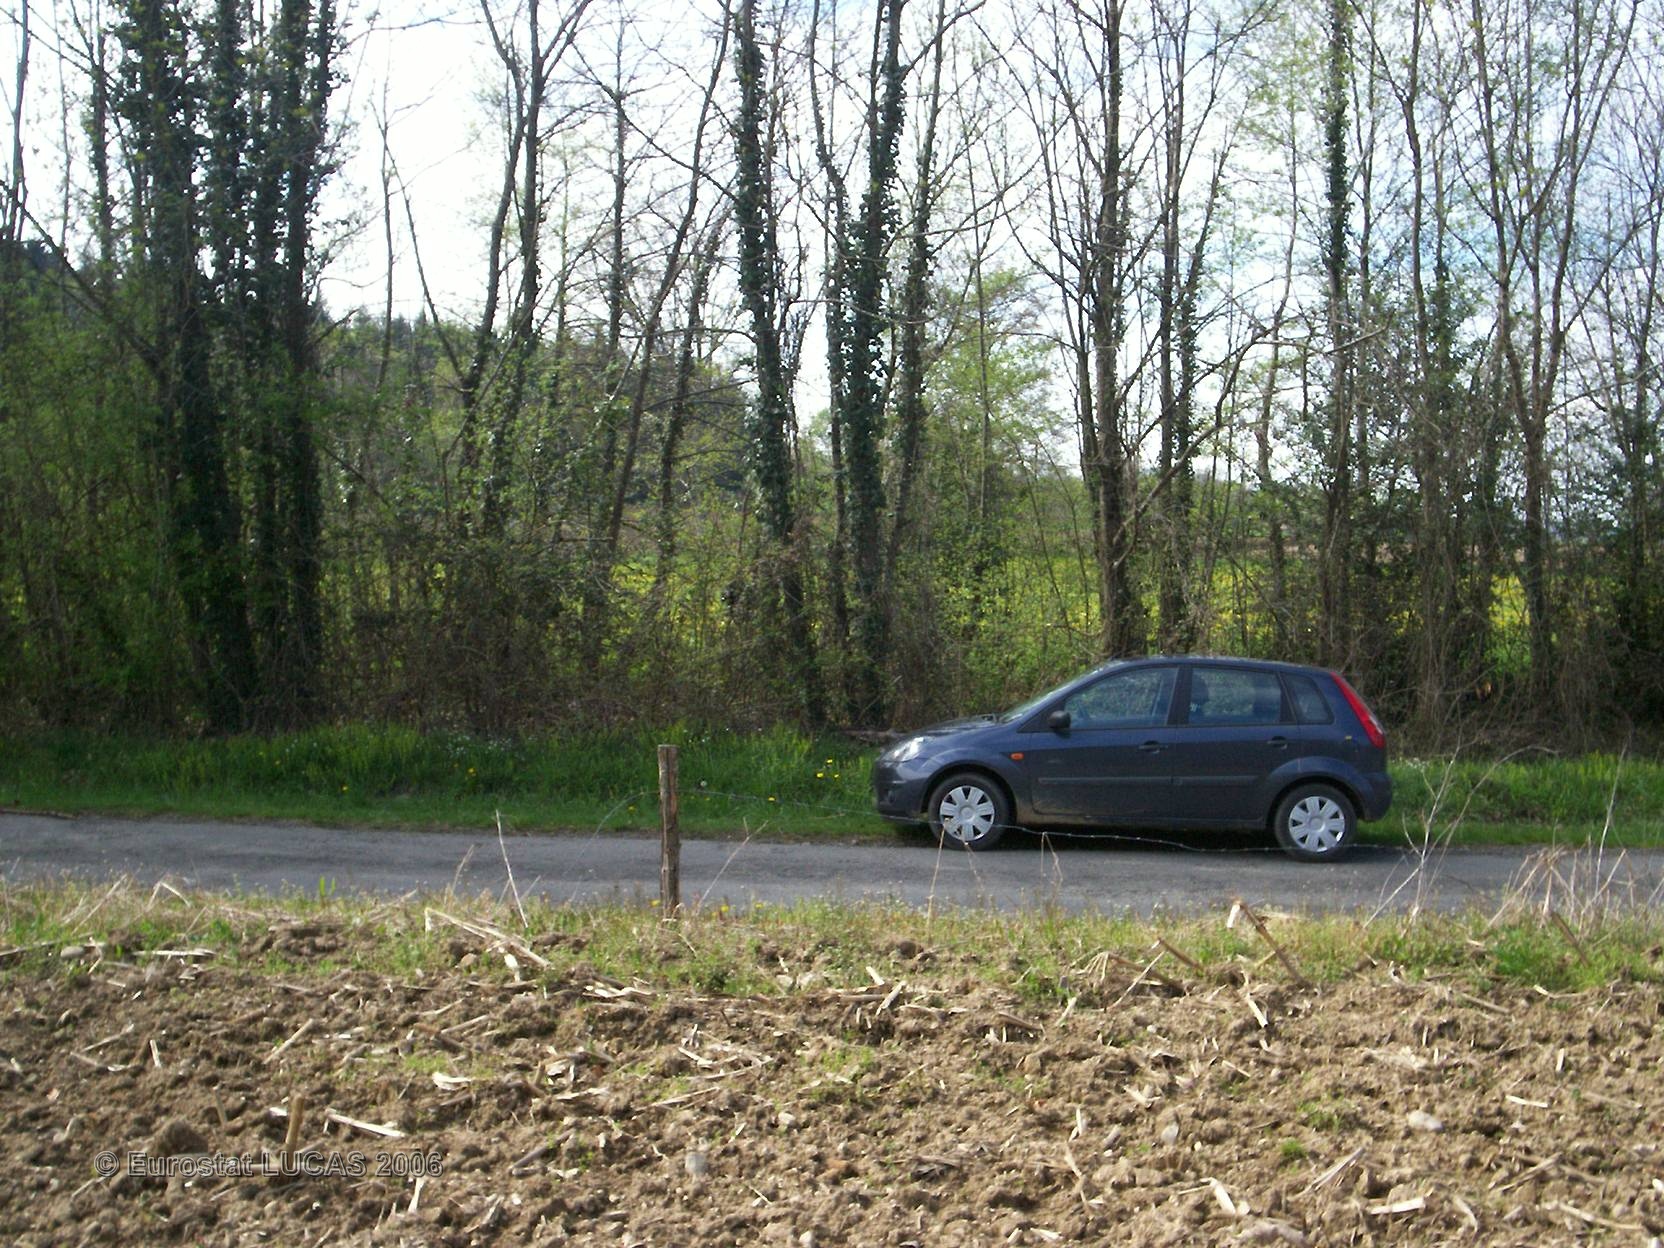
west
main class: Grassland
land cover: Grassland without tree/shrub cover
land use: Agriculture (excluding fallow land and kitchen gardens)
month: June
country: FR
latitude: 43.1635
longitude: -0.1264
